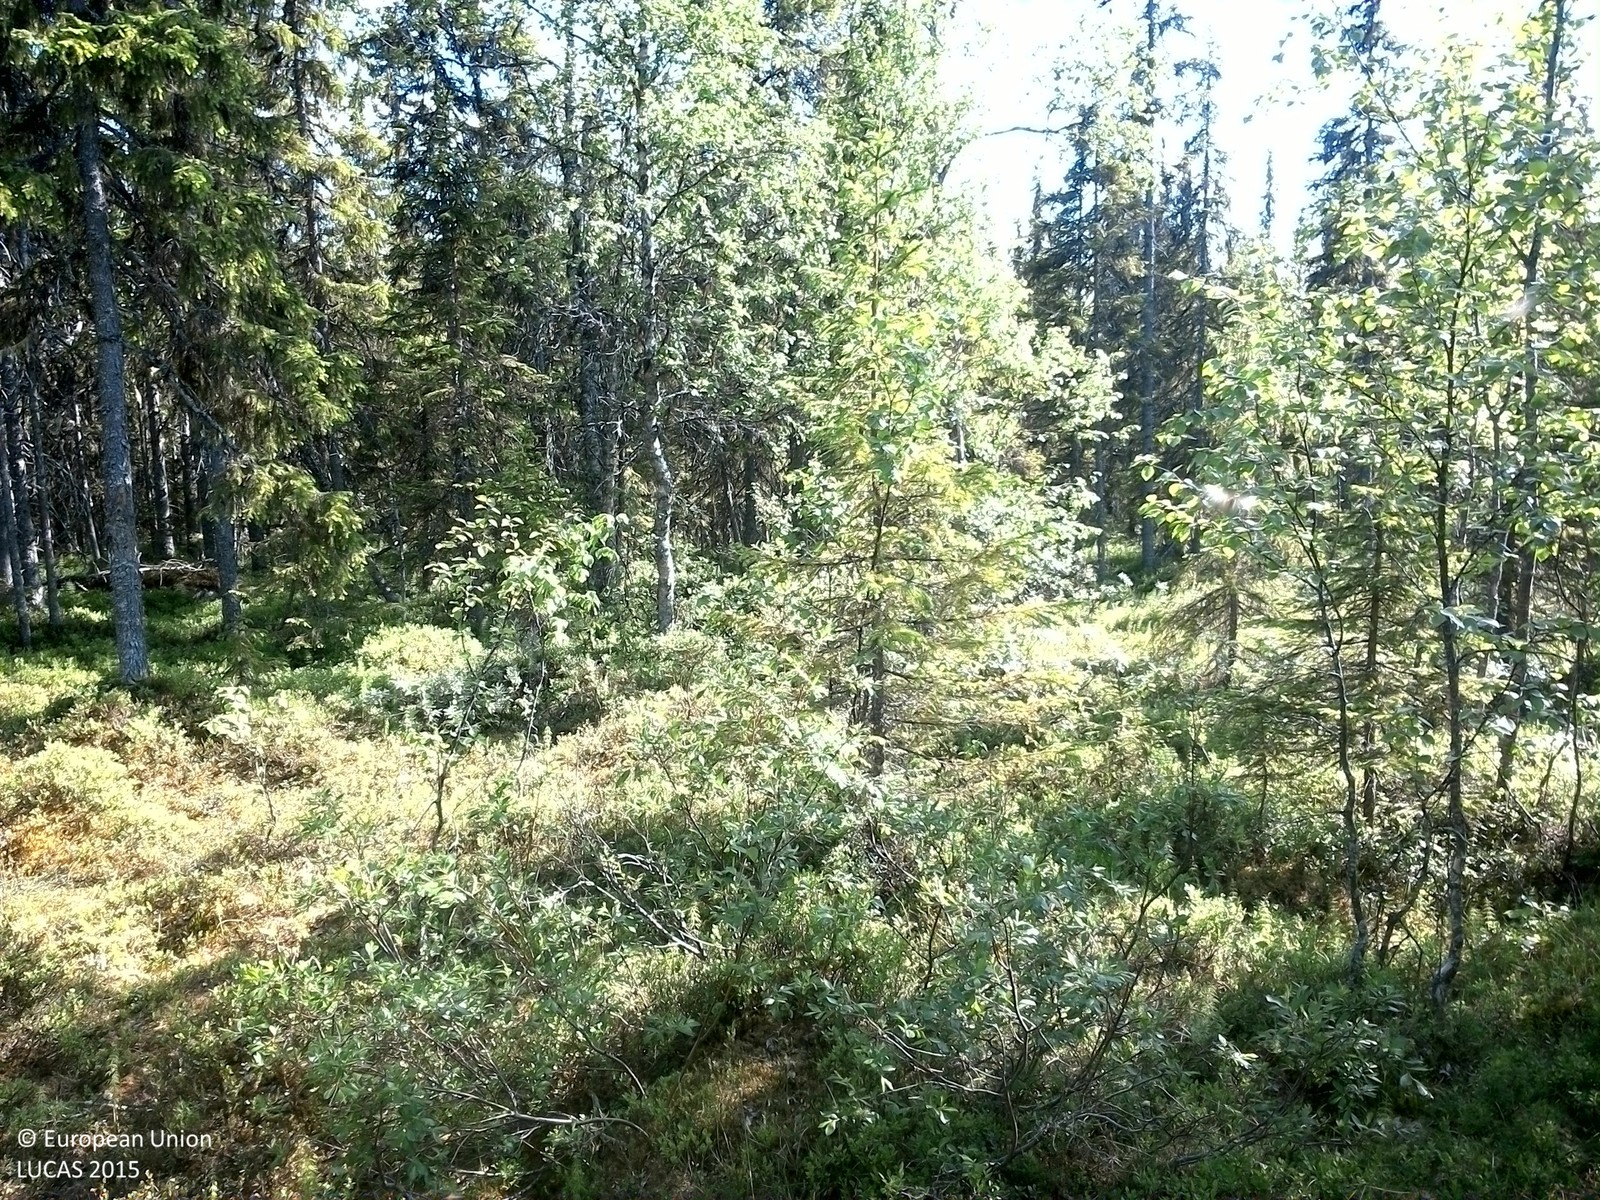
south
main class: Woodland
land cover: Spruce dominated mixed woodland
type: boreal forest
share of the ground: 50 - 75 %
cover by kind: coniferous forest trees 50 %, broadleaved forest trees 20 %, shrubs 15 %, lichens and mosses 10 %, herbaceous plants 5 %
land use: Forestry
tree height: < 5 m
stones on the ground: 10 - 25 %
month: July
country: SE
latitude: 64.3868
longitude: 16.6236
